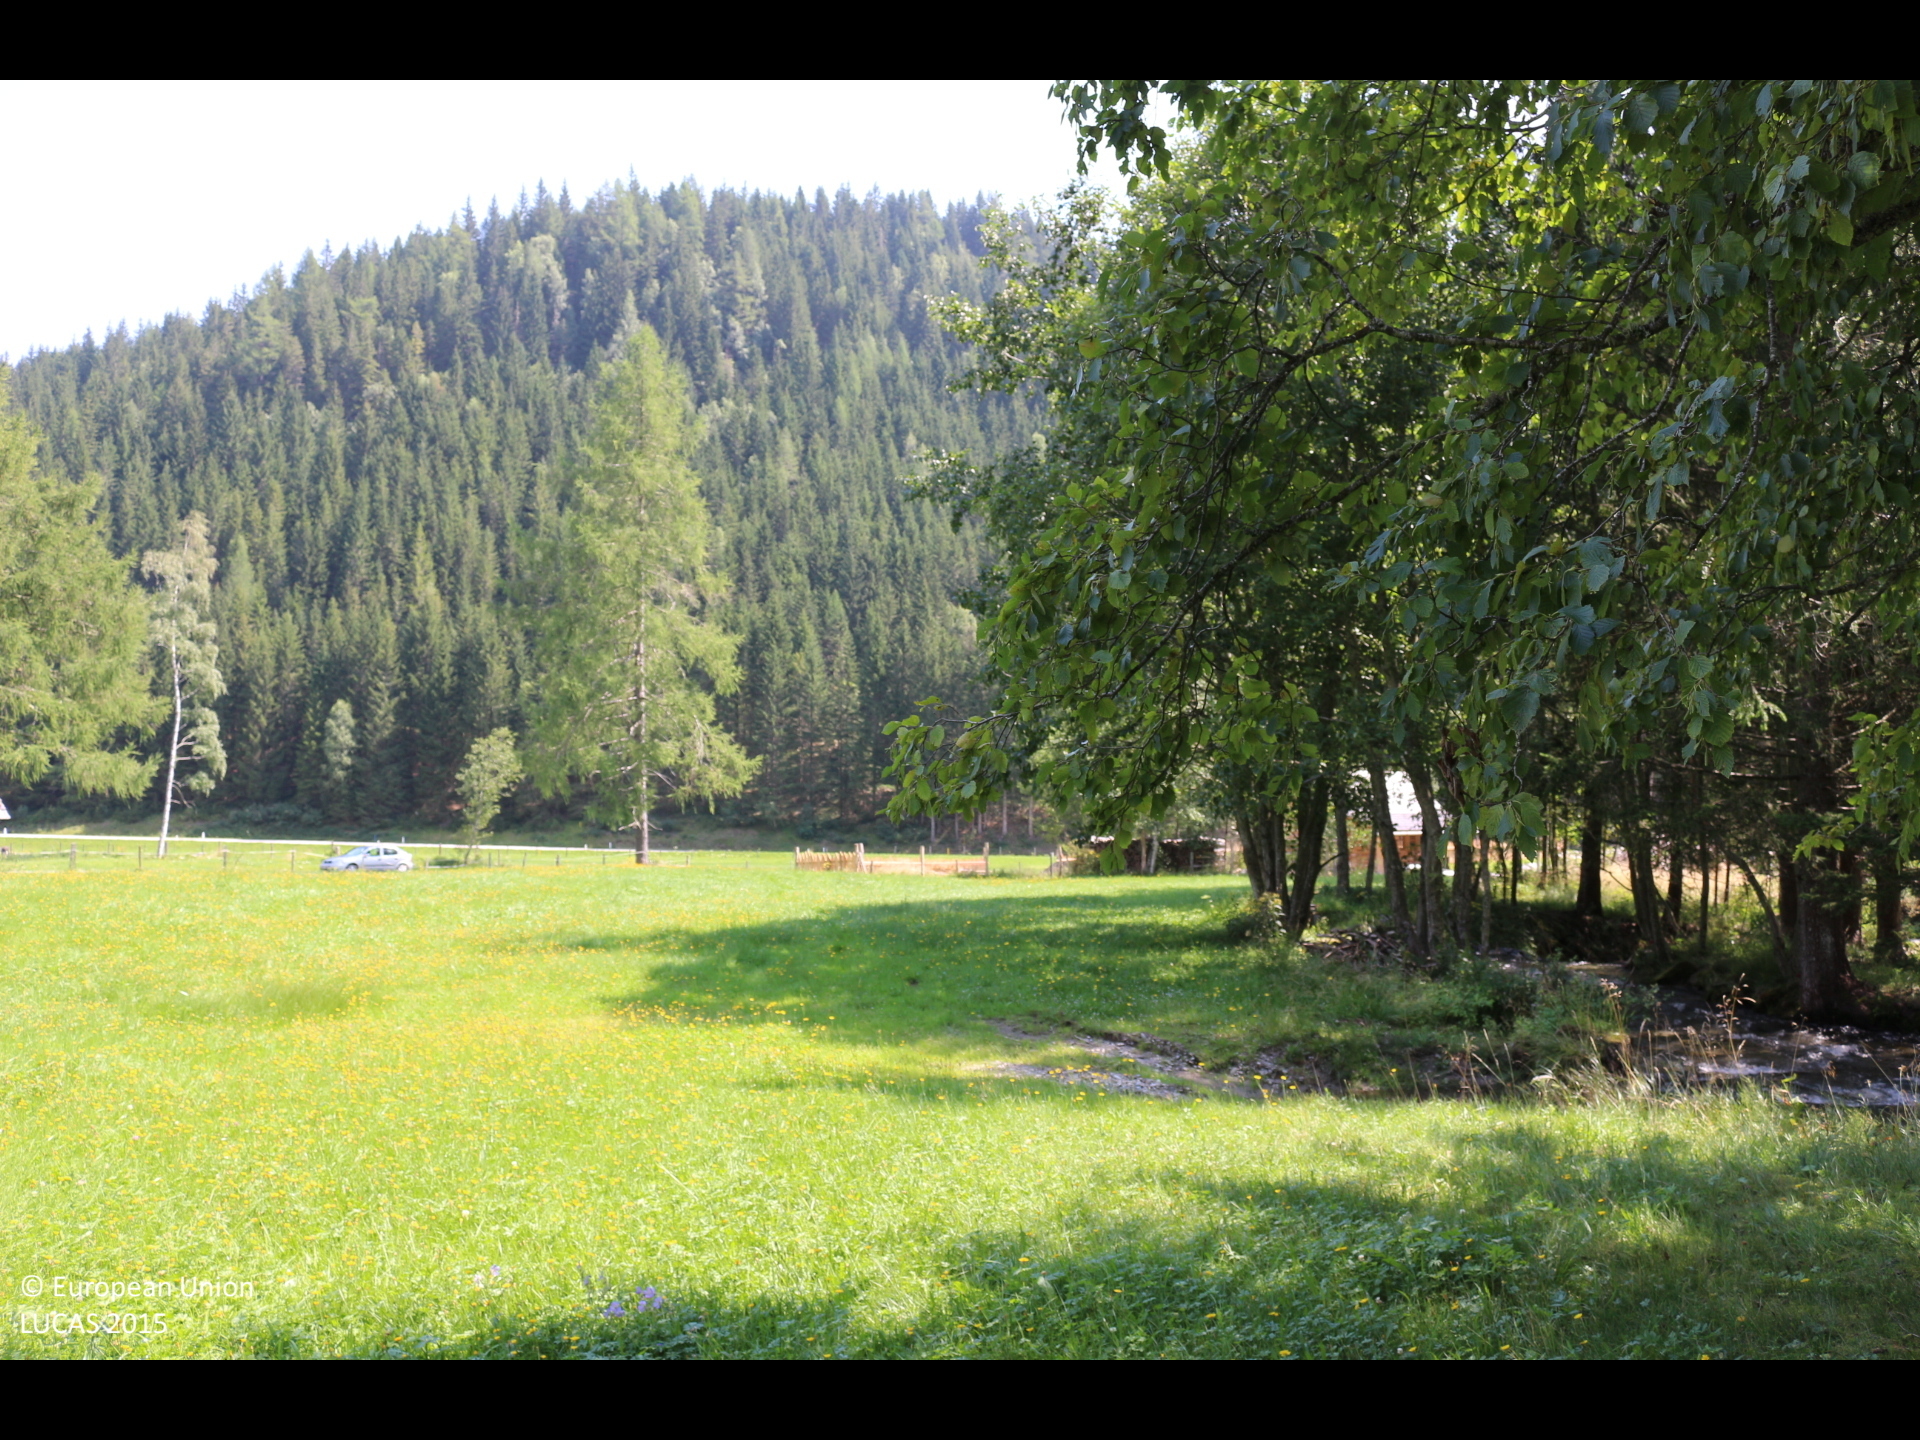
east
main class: Grassland
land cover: Grassland without tree/shrub cover
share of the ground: > 75 %
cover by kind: herbaceous plants 100 %
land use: Agriculture (excluding fallow land and kitchen gardens)
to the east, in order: Grassland without tree/shrub cover; Fences; Artificial constructions in urban areas; Tracks; Fences; Grassland without tree/shrub cover; Fences; Paved roads, cycling and walking lanes; Spruce dominated coniferous woodland; Tracks; Spruce dominated coniferous woodland
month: August
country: AT
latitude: 47.0283
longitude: 14.1428
